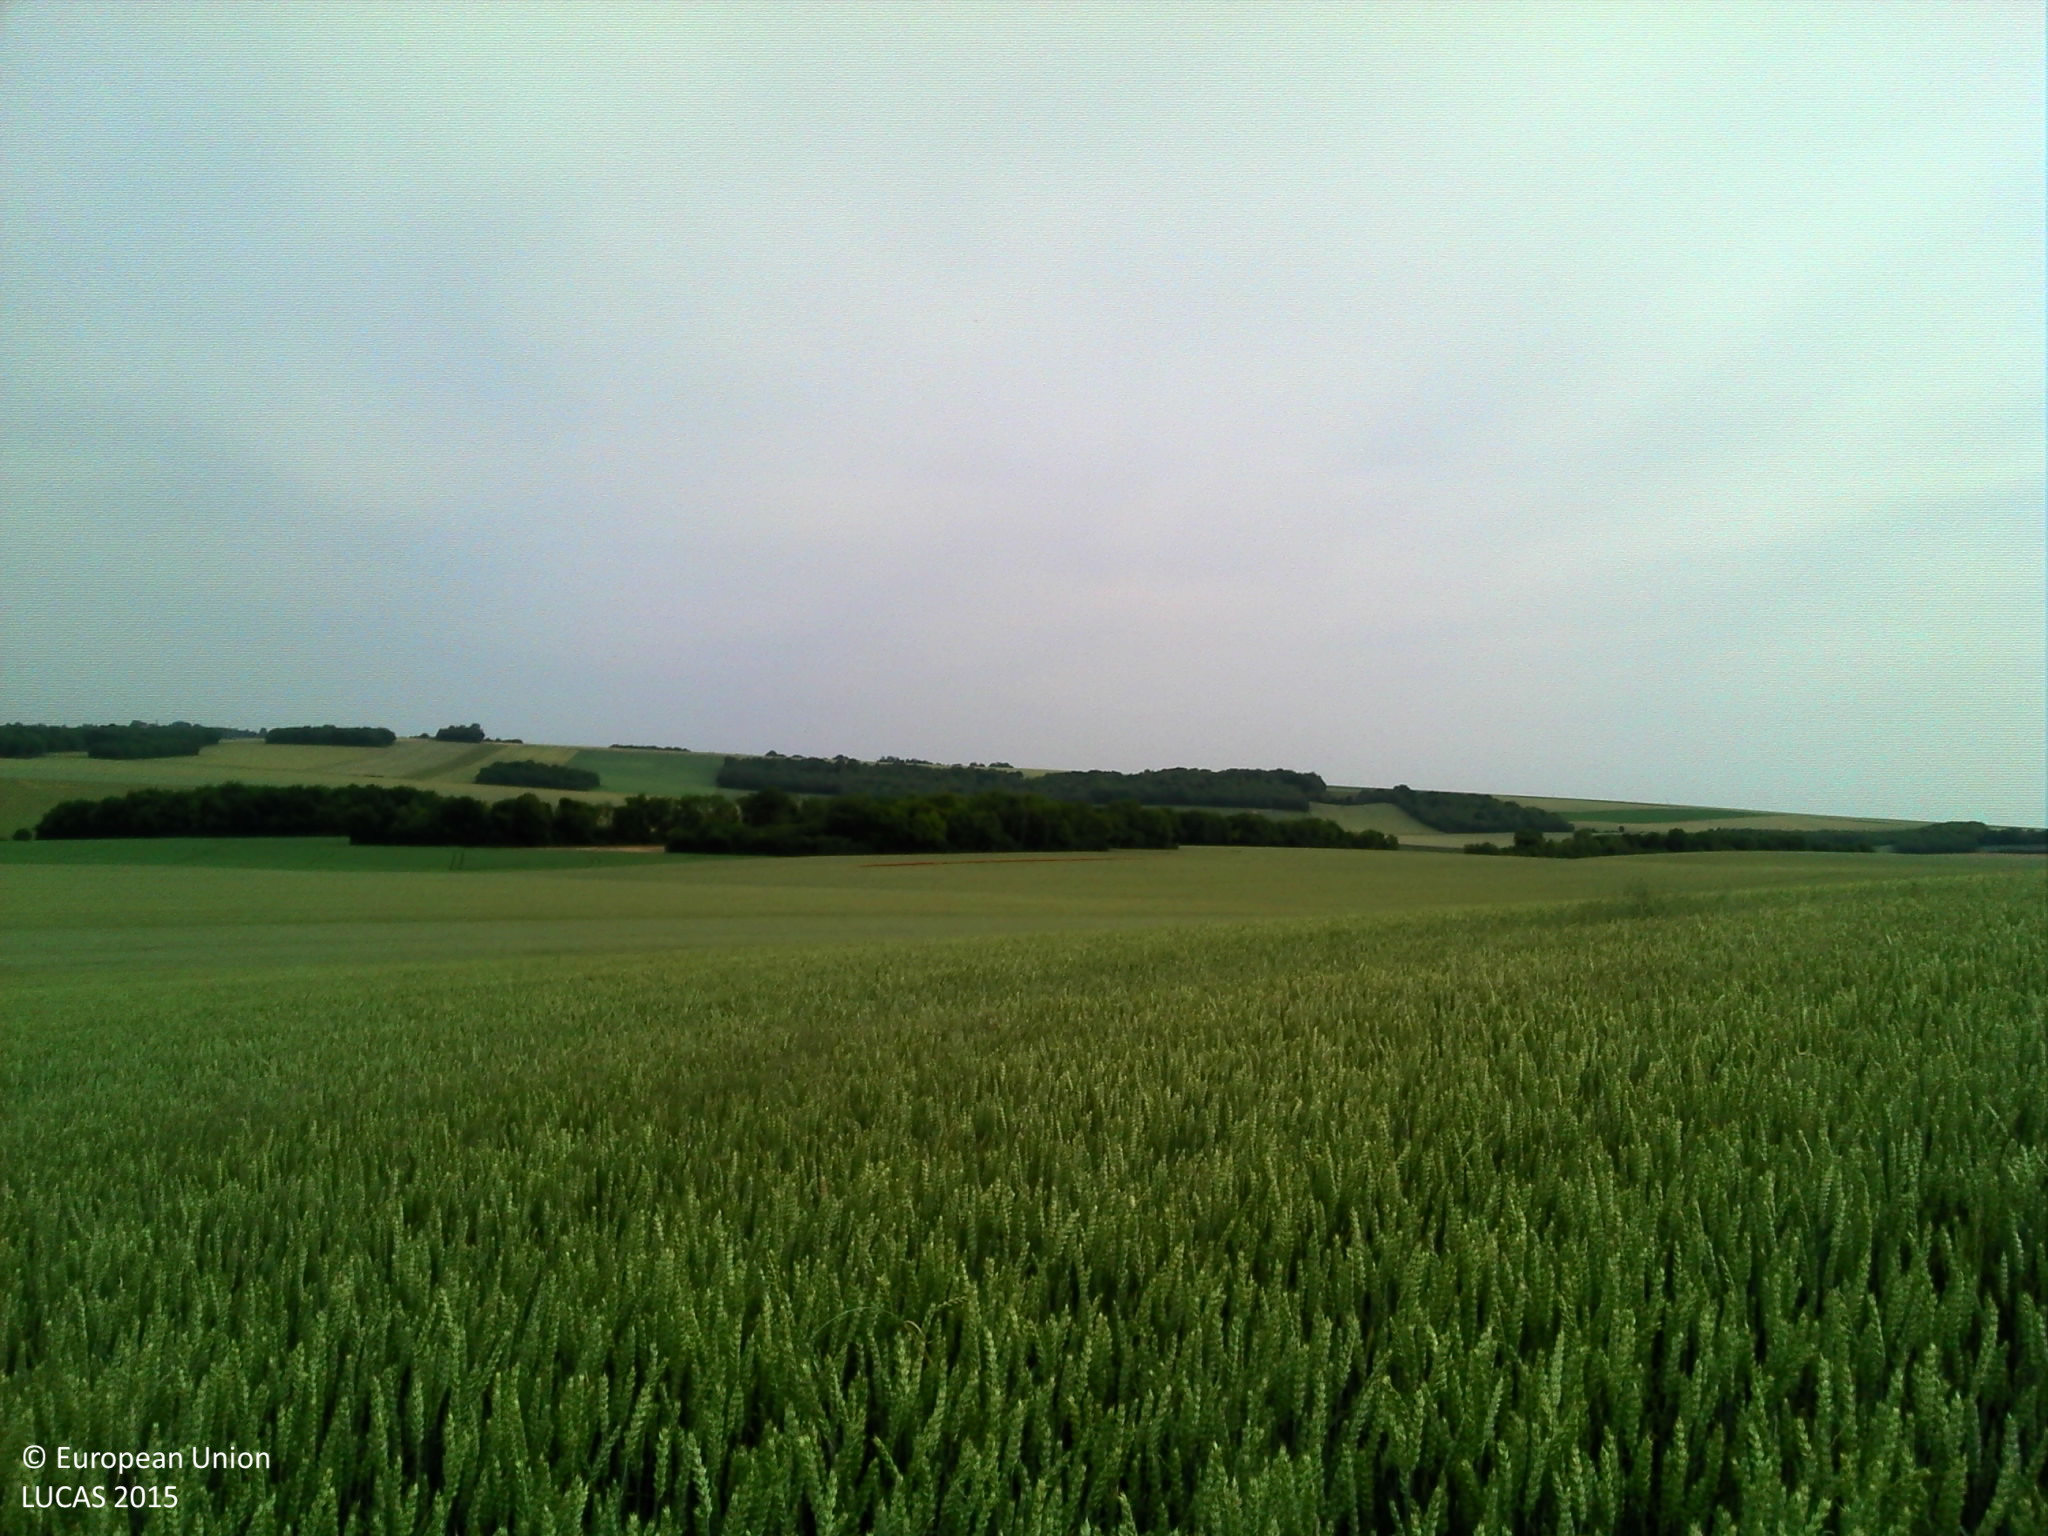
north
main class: Cropland
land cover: Common wheat
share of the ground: > 75 %
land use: Agriculture (excluding fallow land and kitchen gardens)
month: June
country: FR
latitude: 49.6403
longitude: 2.3848
